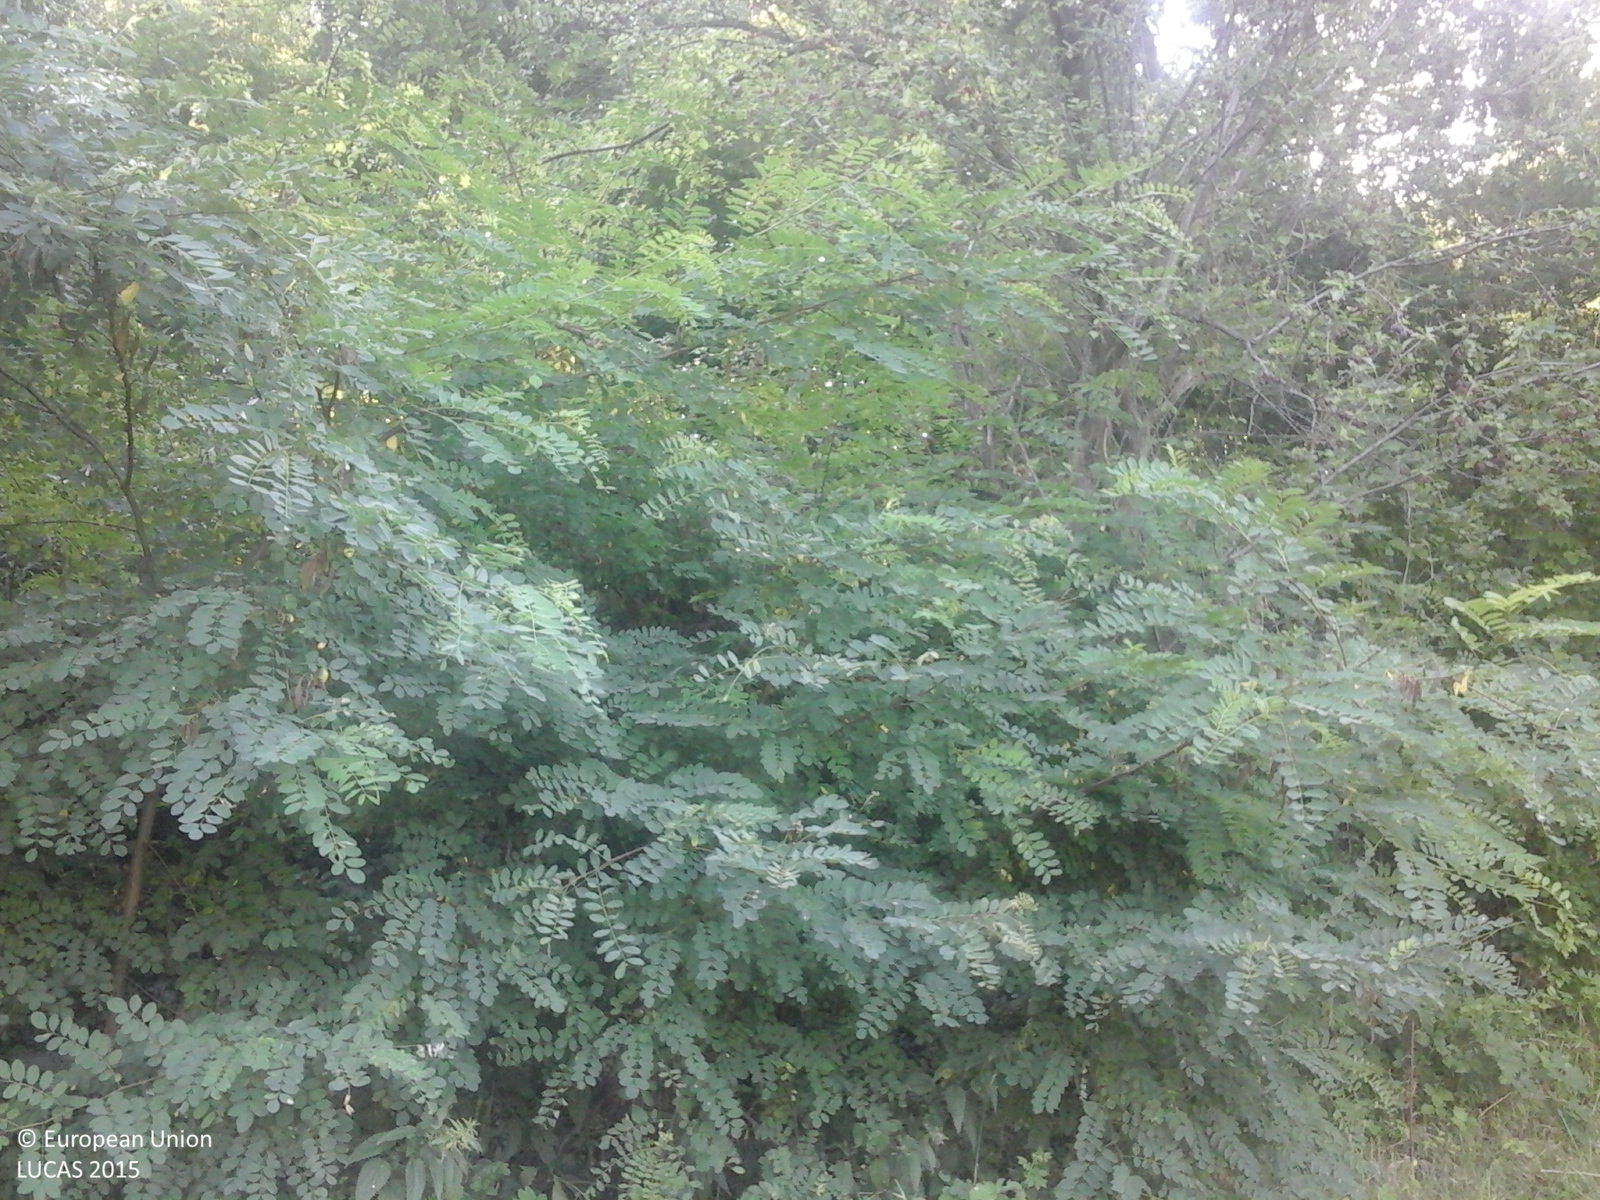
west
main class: Woodland
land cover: Broadleaved woodland
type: exotic forest
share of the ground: > 75 %
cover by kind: broadleaved forest trees 100 %
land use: Forestry
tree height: > 5 m
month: July
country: RO
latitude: 45.0371
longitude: 24.4313
